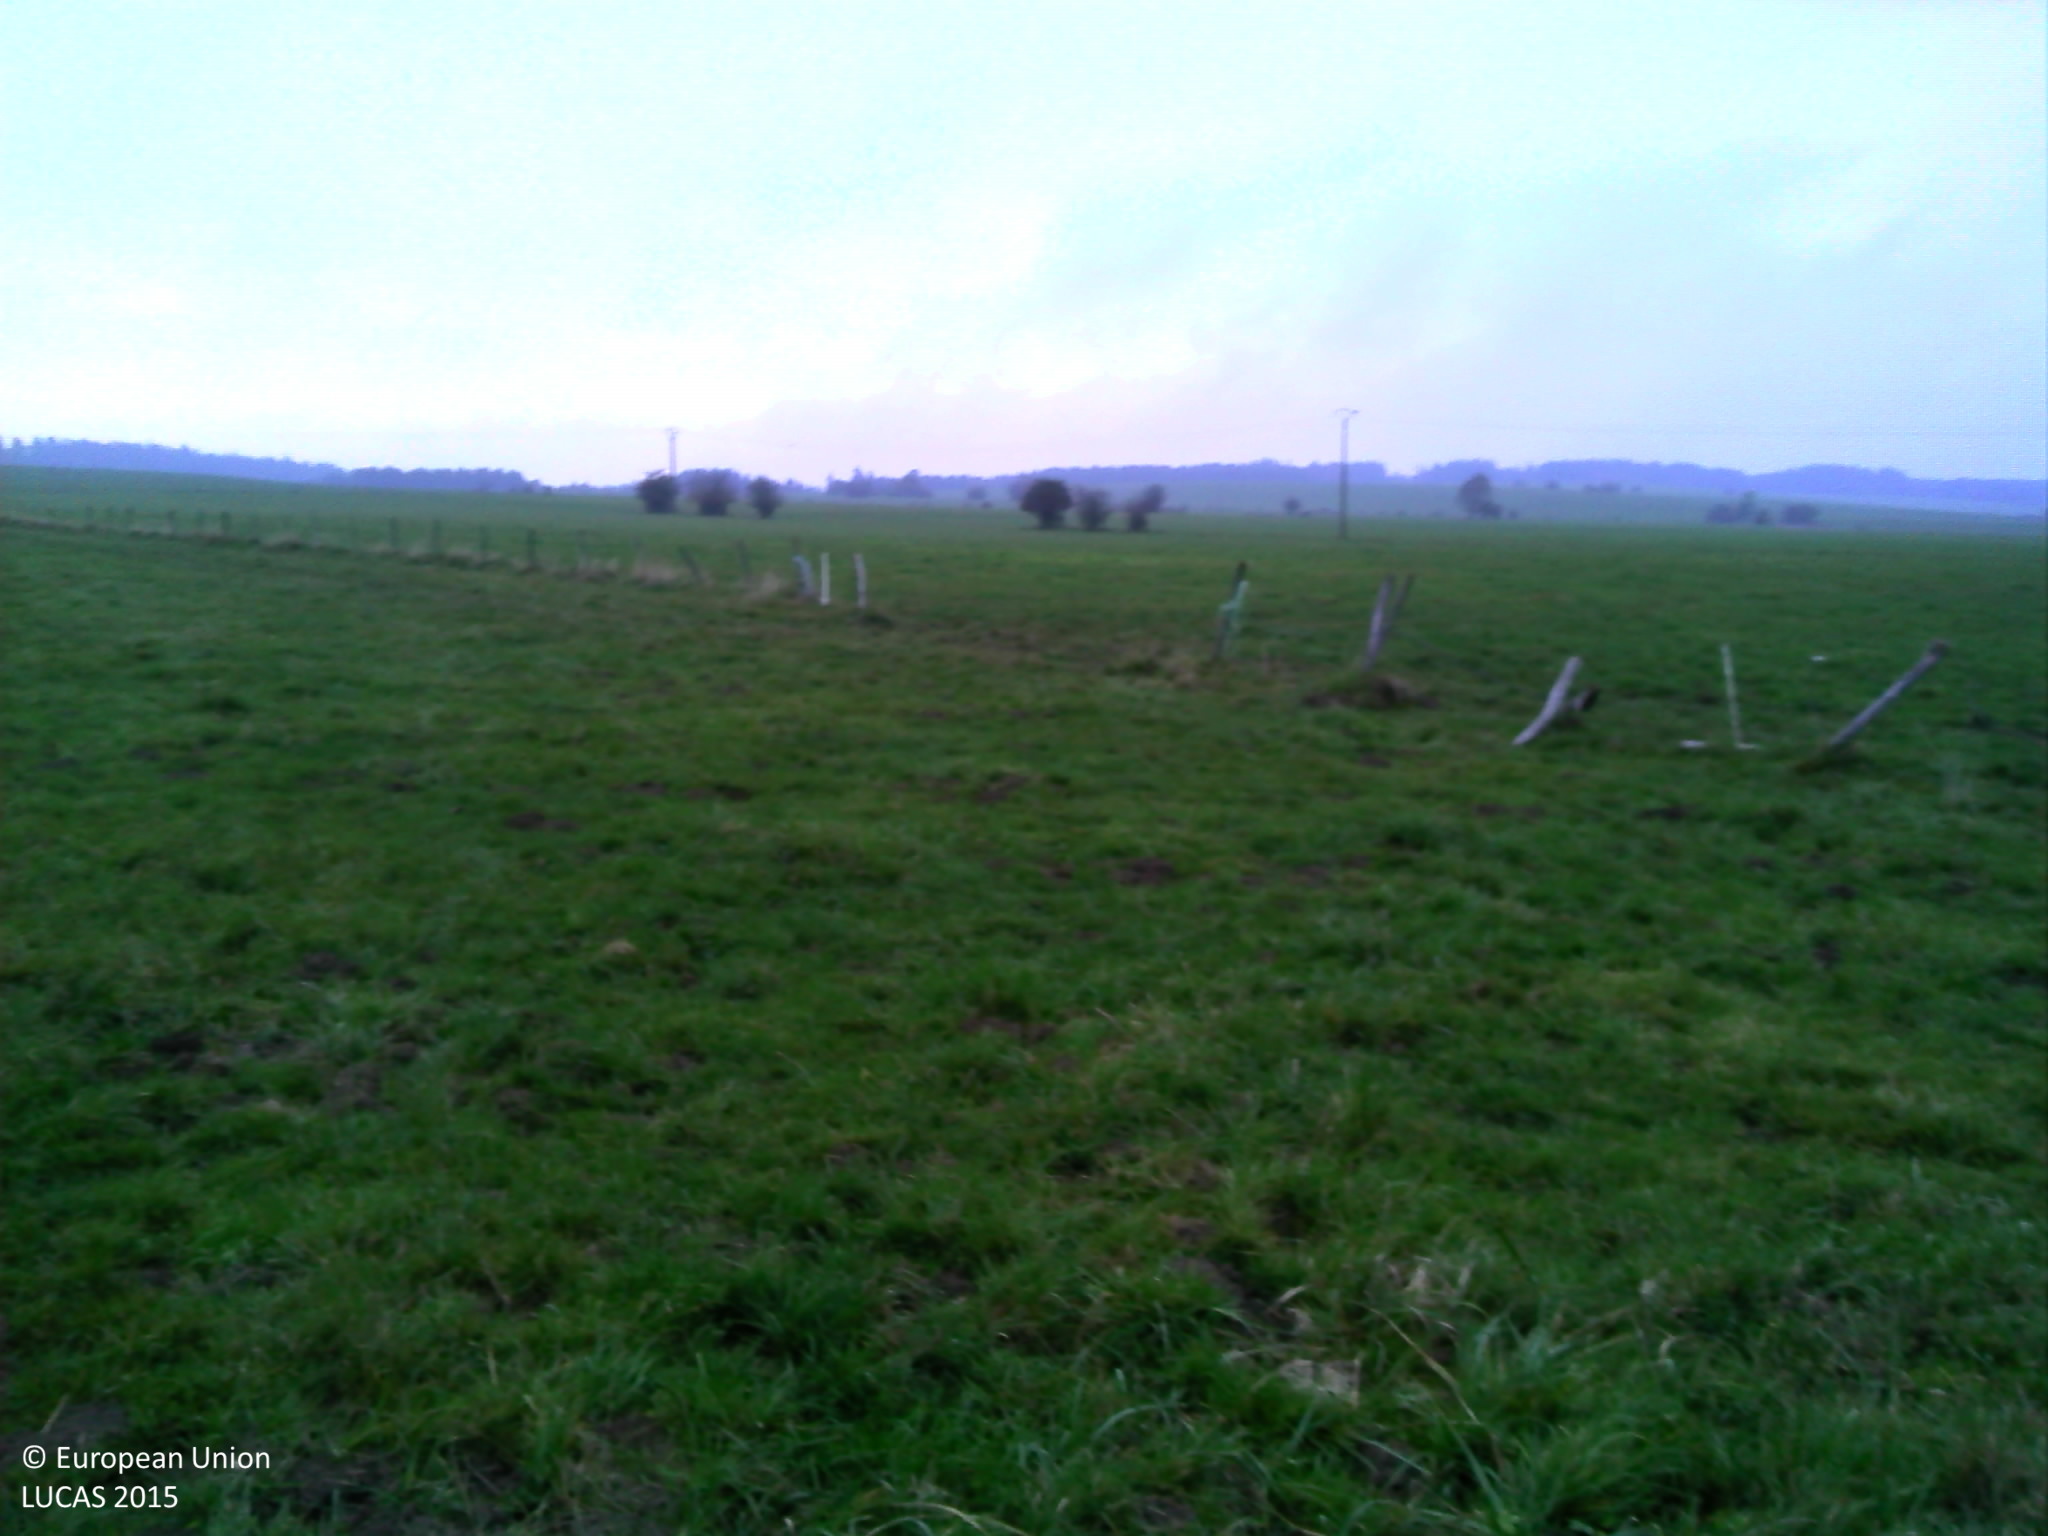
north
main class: Grassland
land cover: Grassland without tree/shrub cover
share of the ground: > 75 %
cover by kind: herbaceous plants 100 %
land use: Agriculture (excluding fallow land and kitchen gardens)
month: October
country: FR
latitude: 46.8923
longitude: 6.0780
